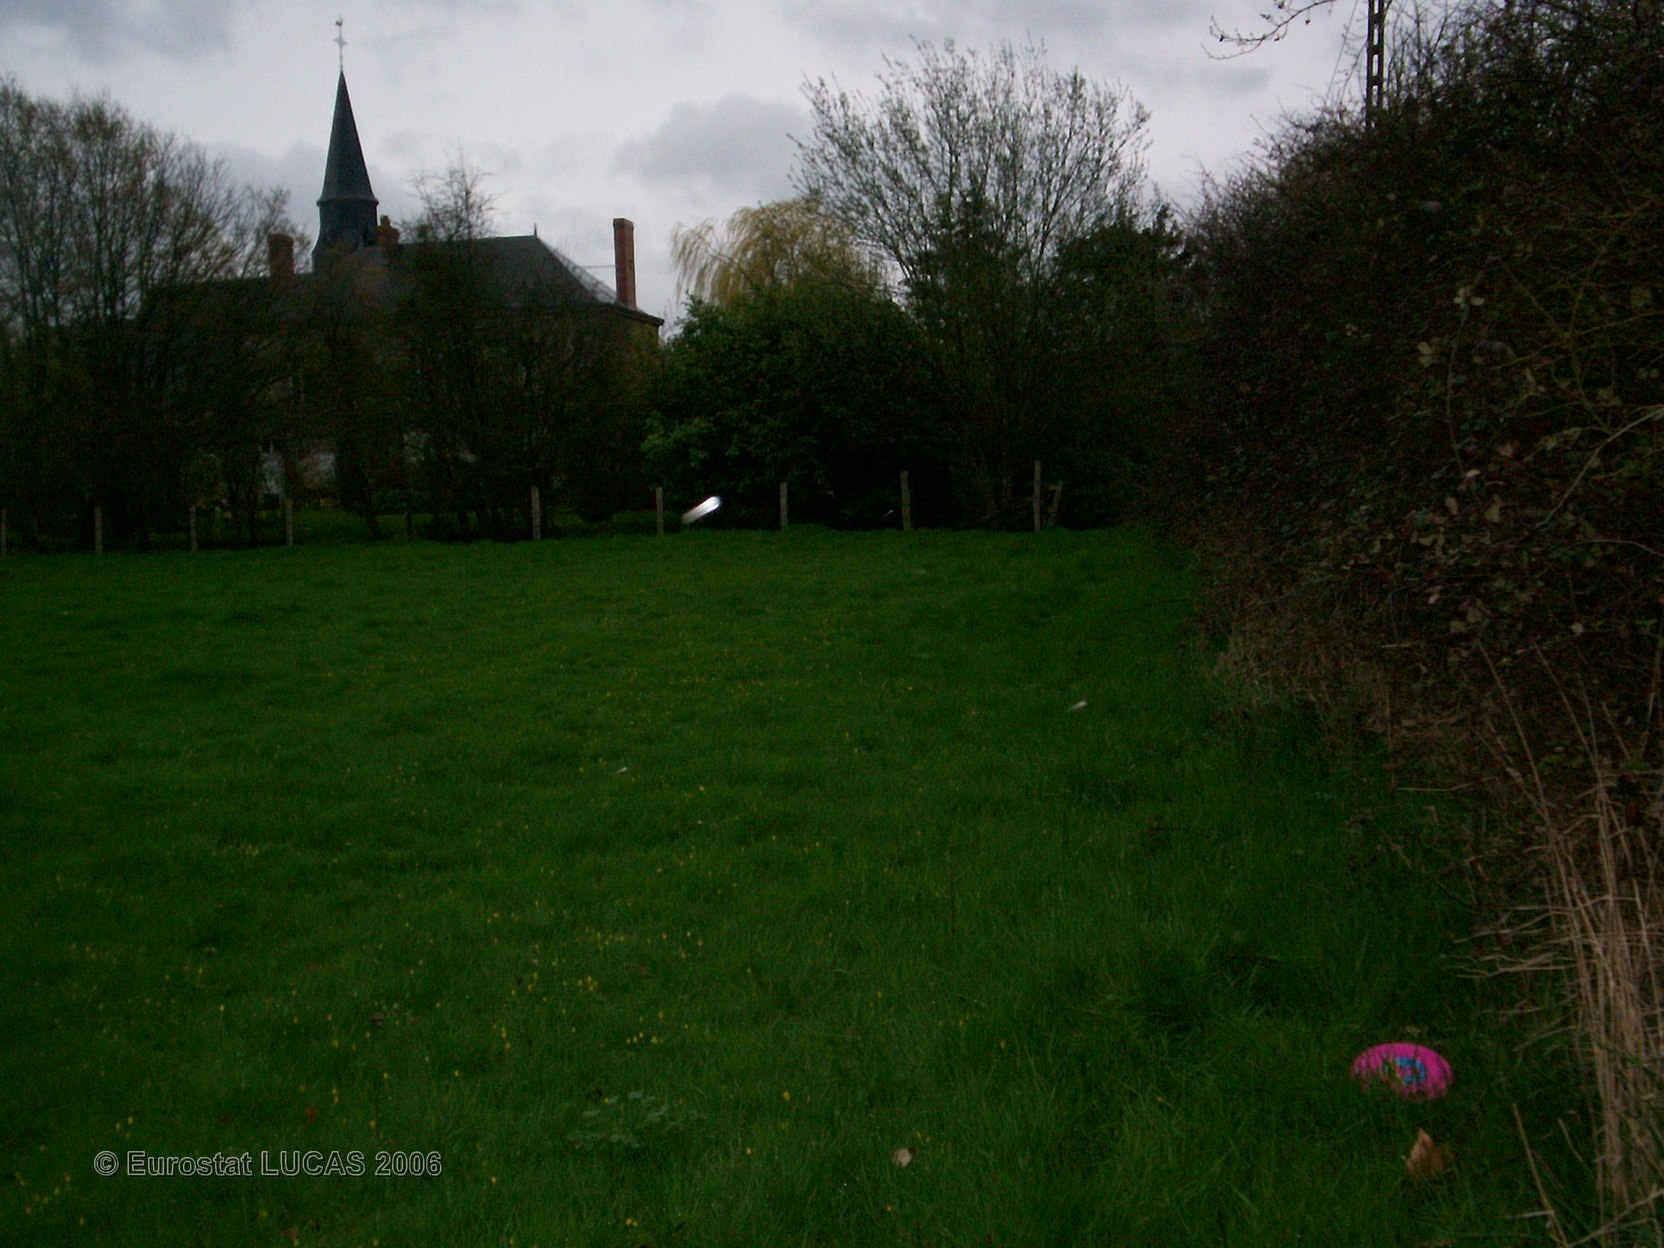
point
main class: Grassland
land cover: Grassland without tree/shrub cover
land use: Agriculture (excluding fallow land and kitchen gardens)
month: April
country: FR
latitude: 48.4656
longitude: 0.3034
